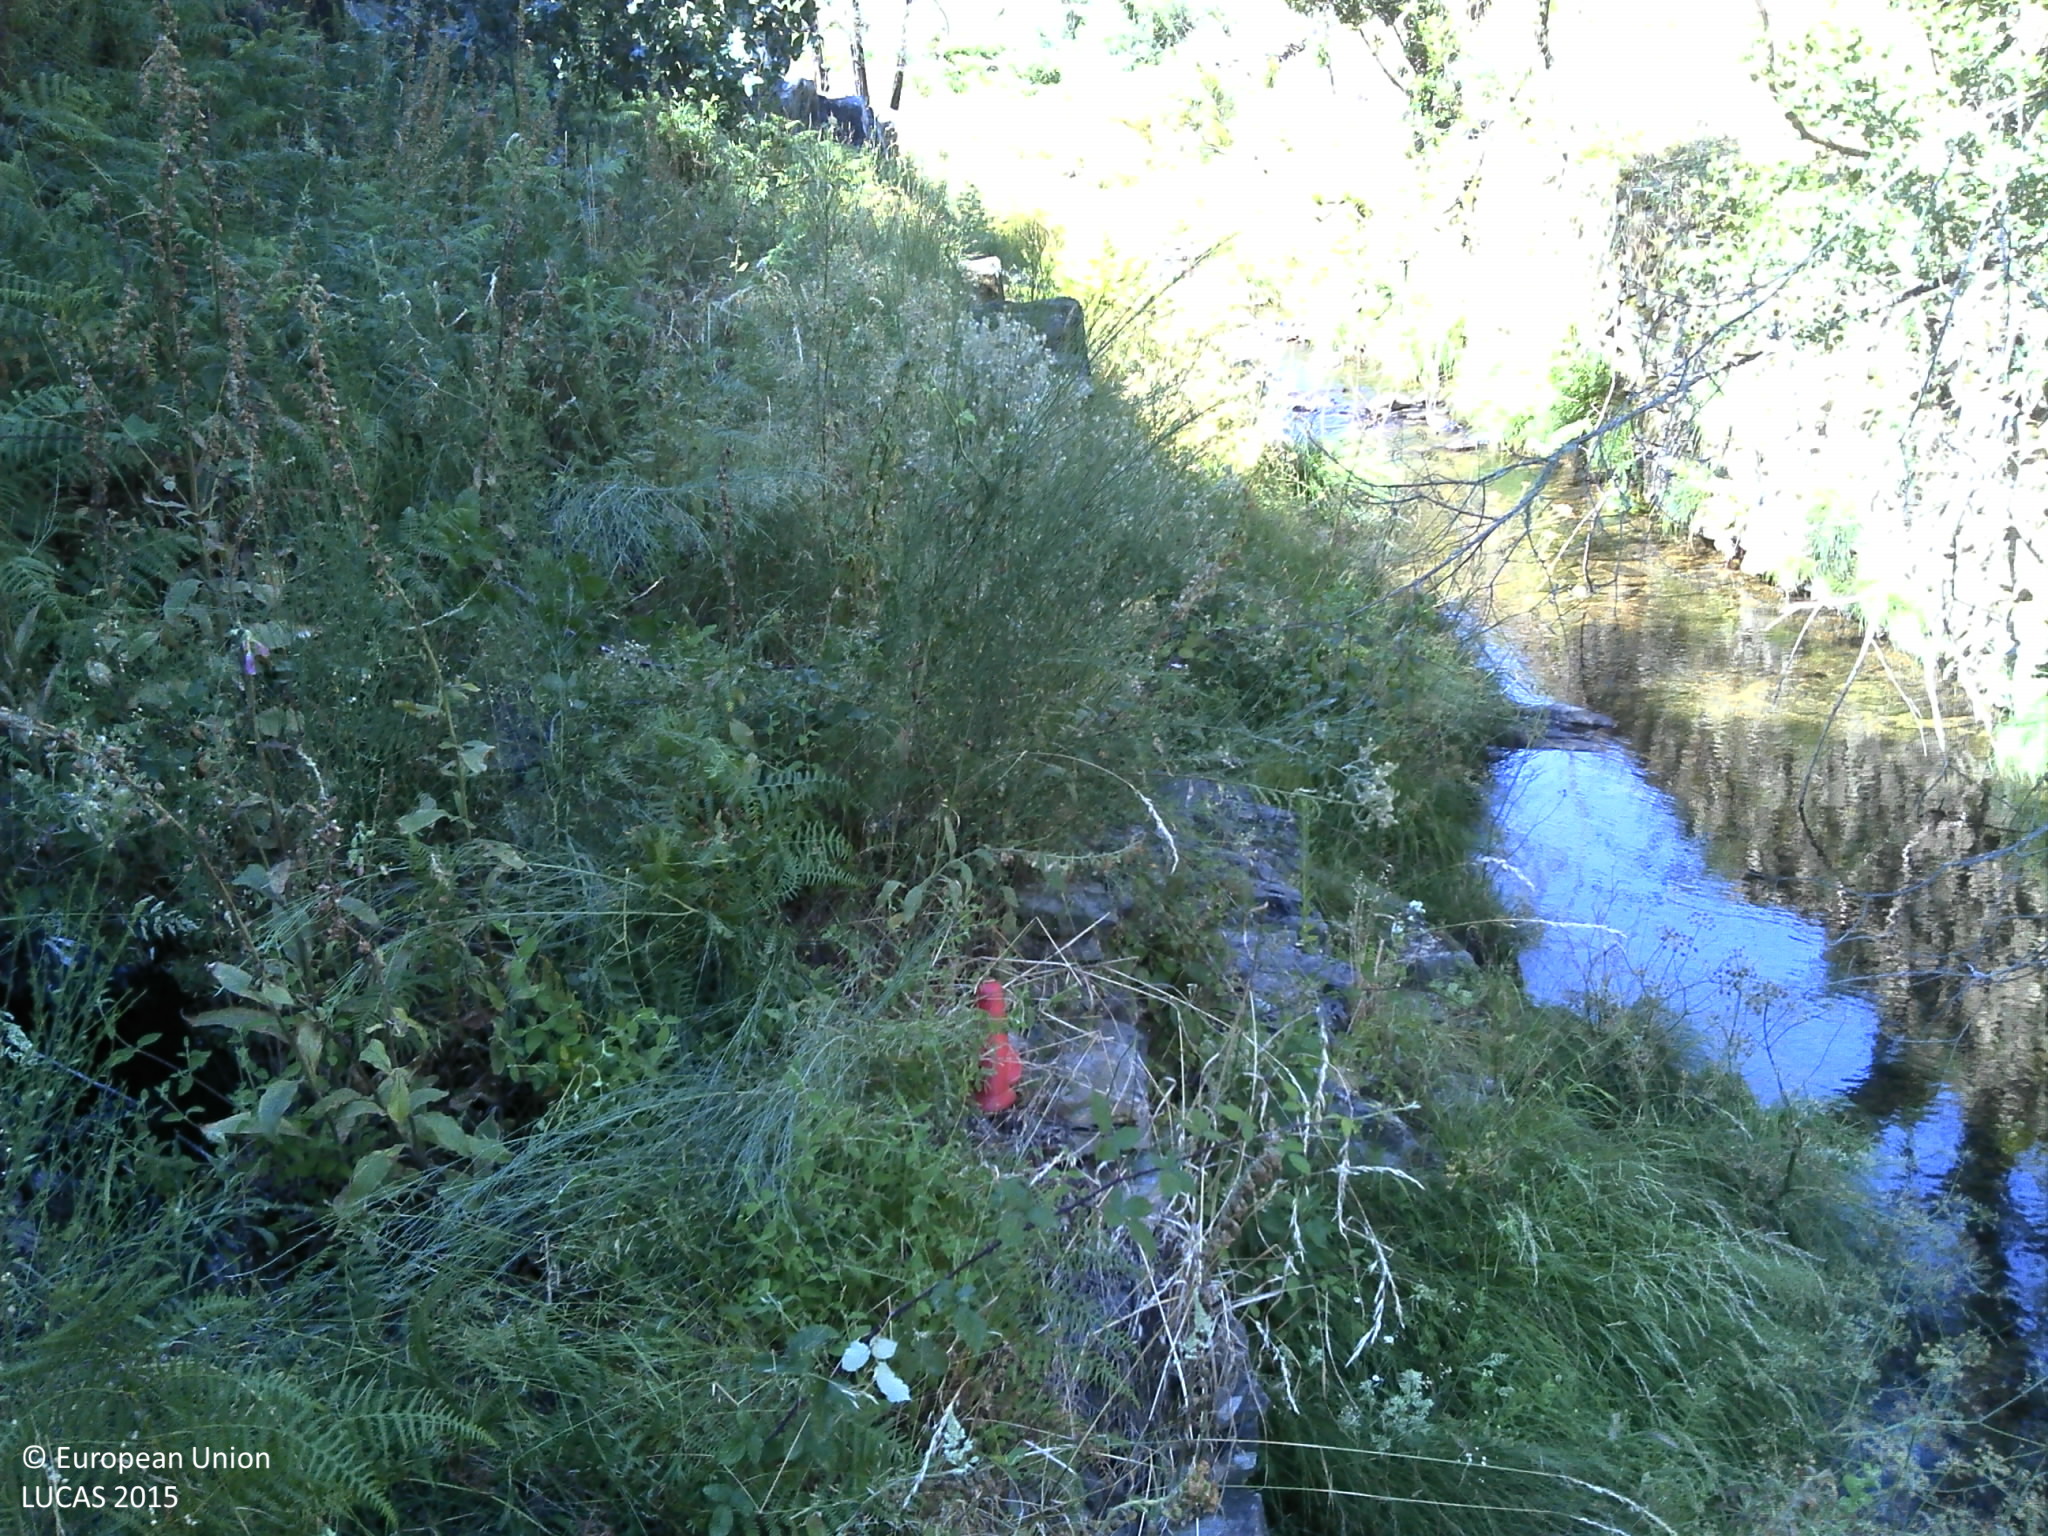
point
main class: Shrubland
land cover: Shrubland with sparse tree cover
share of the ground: > 75 %
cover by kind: shrubs 80 %, unconsolidated bare surface 15 %, broadleaved forest trees 5 %
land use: Abandoned areas
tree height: < 5 m
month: June
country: PT
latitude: 40.0489
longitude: -8.0876
